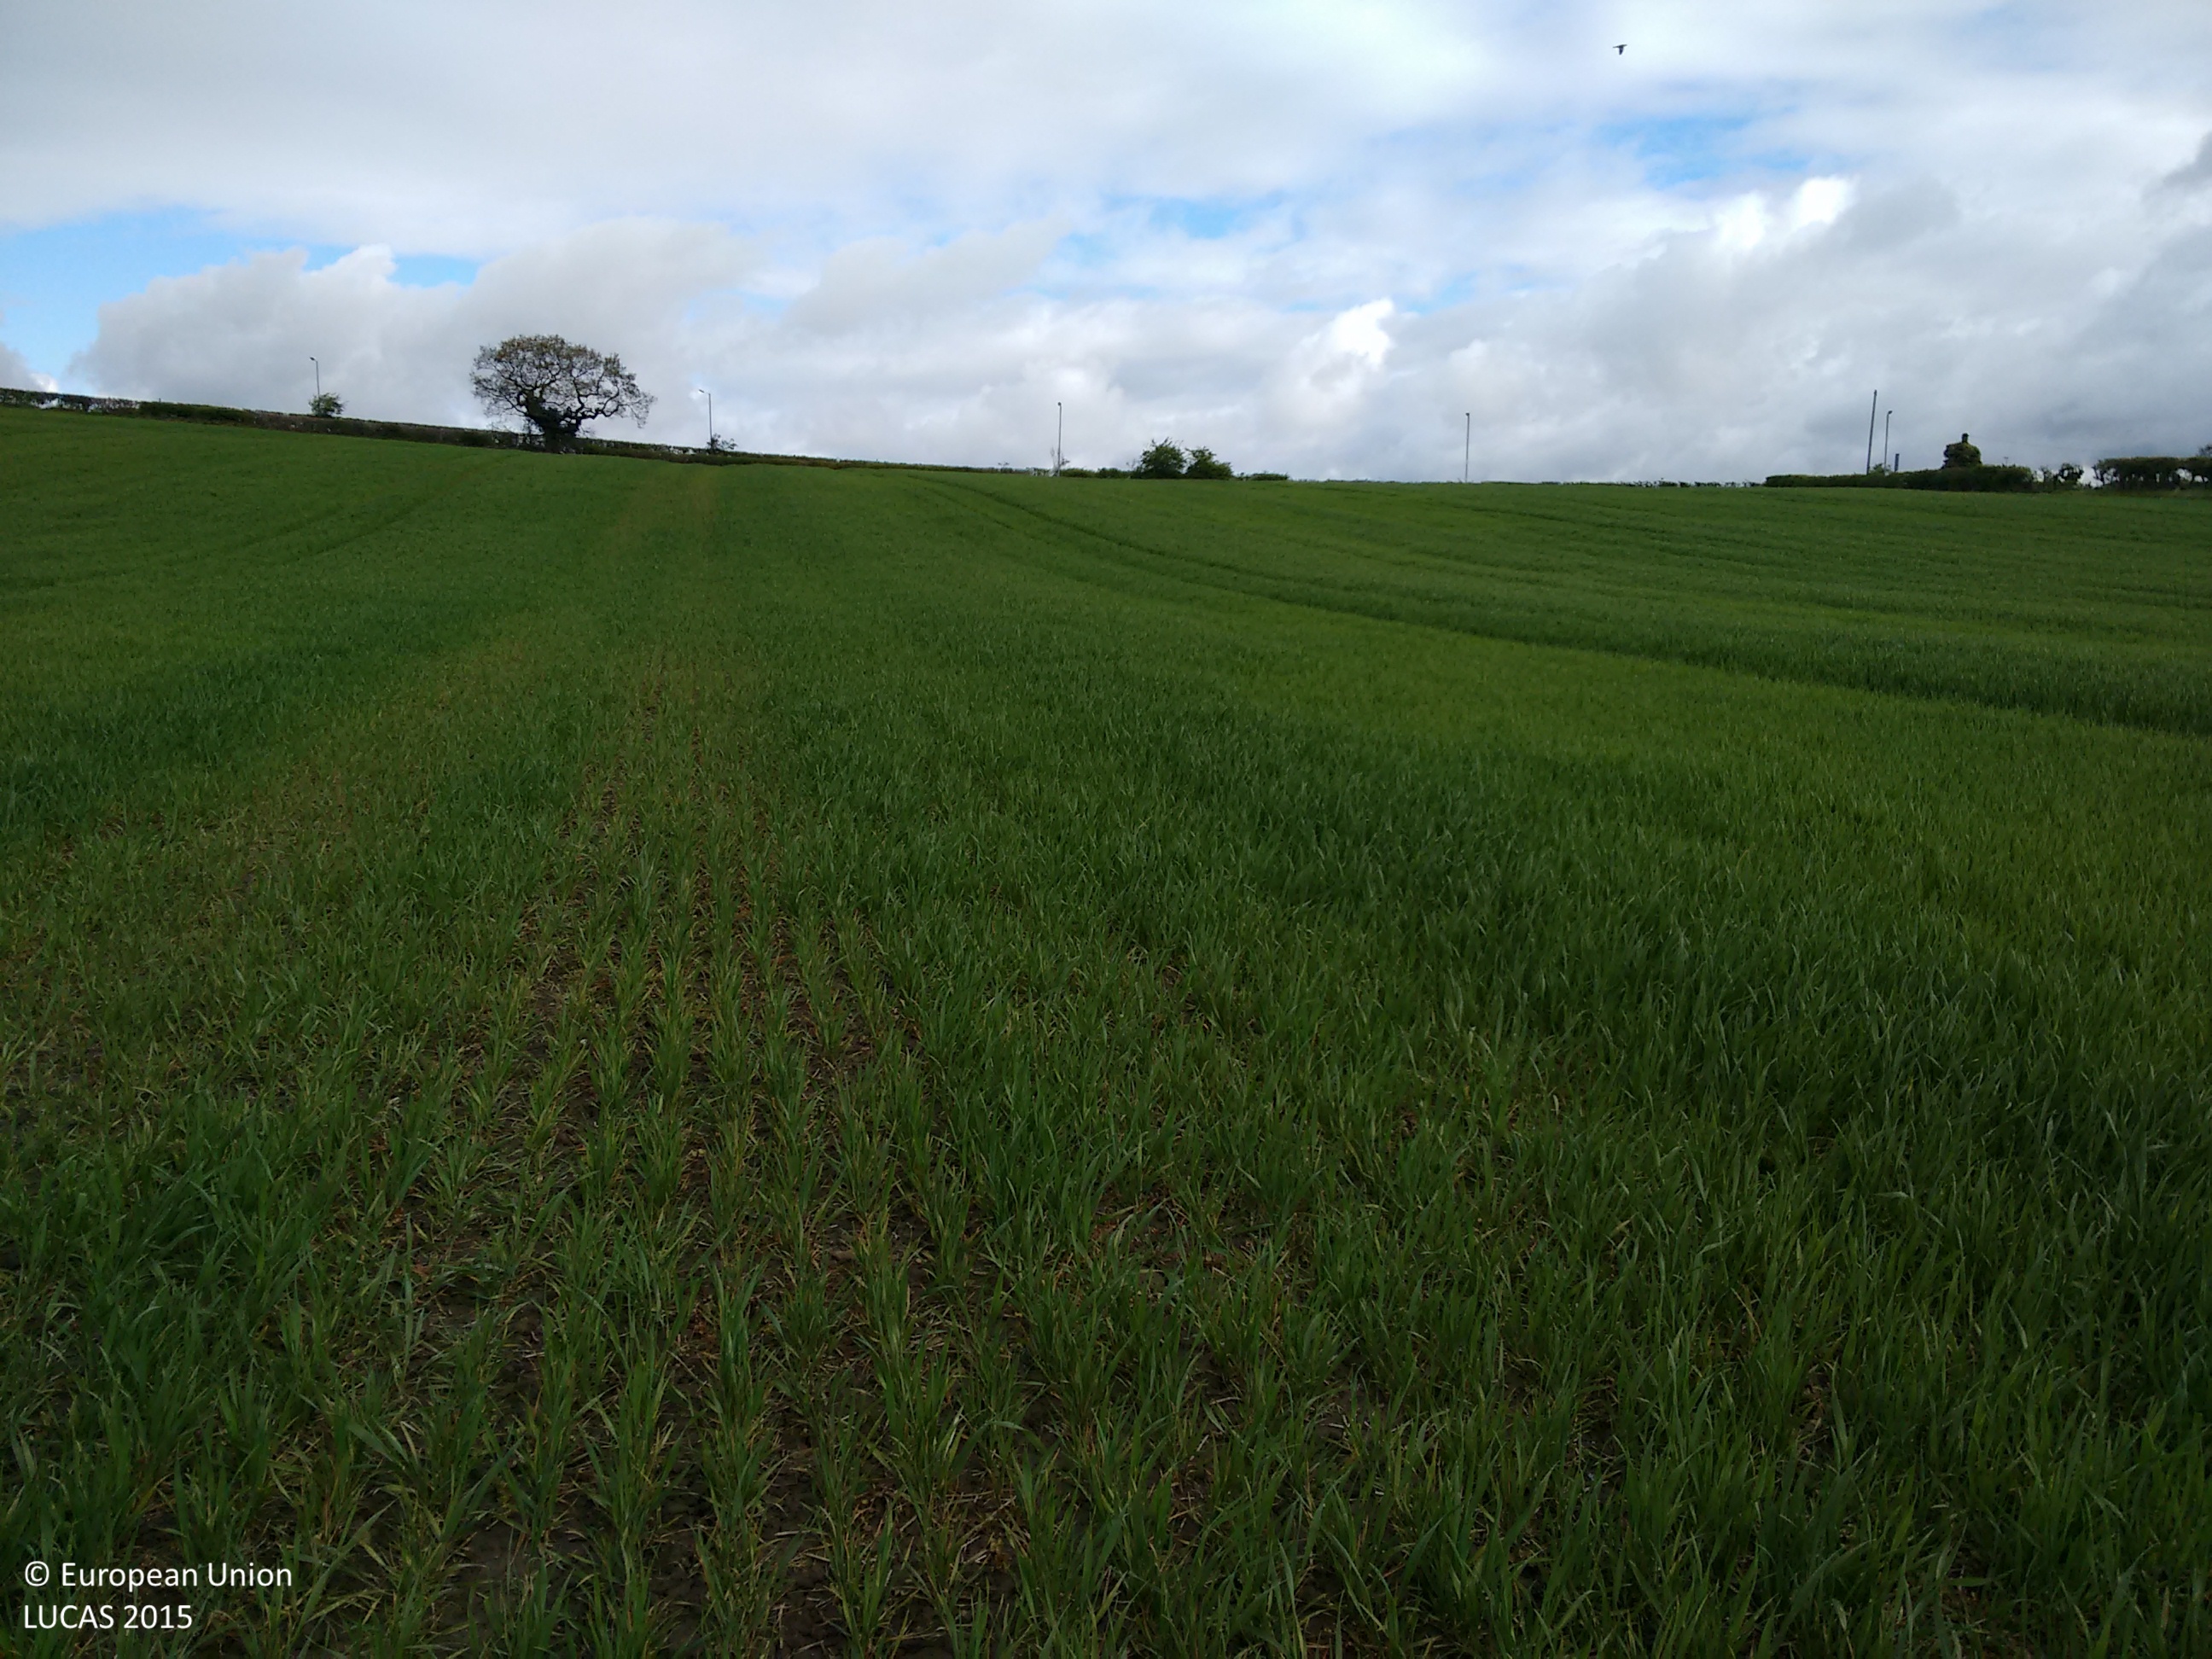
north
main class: Cropland
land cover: Common wheat
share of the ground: > 75 %
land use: Agriculture (excluding fallow land and kitchen gardens)
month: April
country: GB
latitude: 53.6603
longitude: -1.5974
